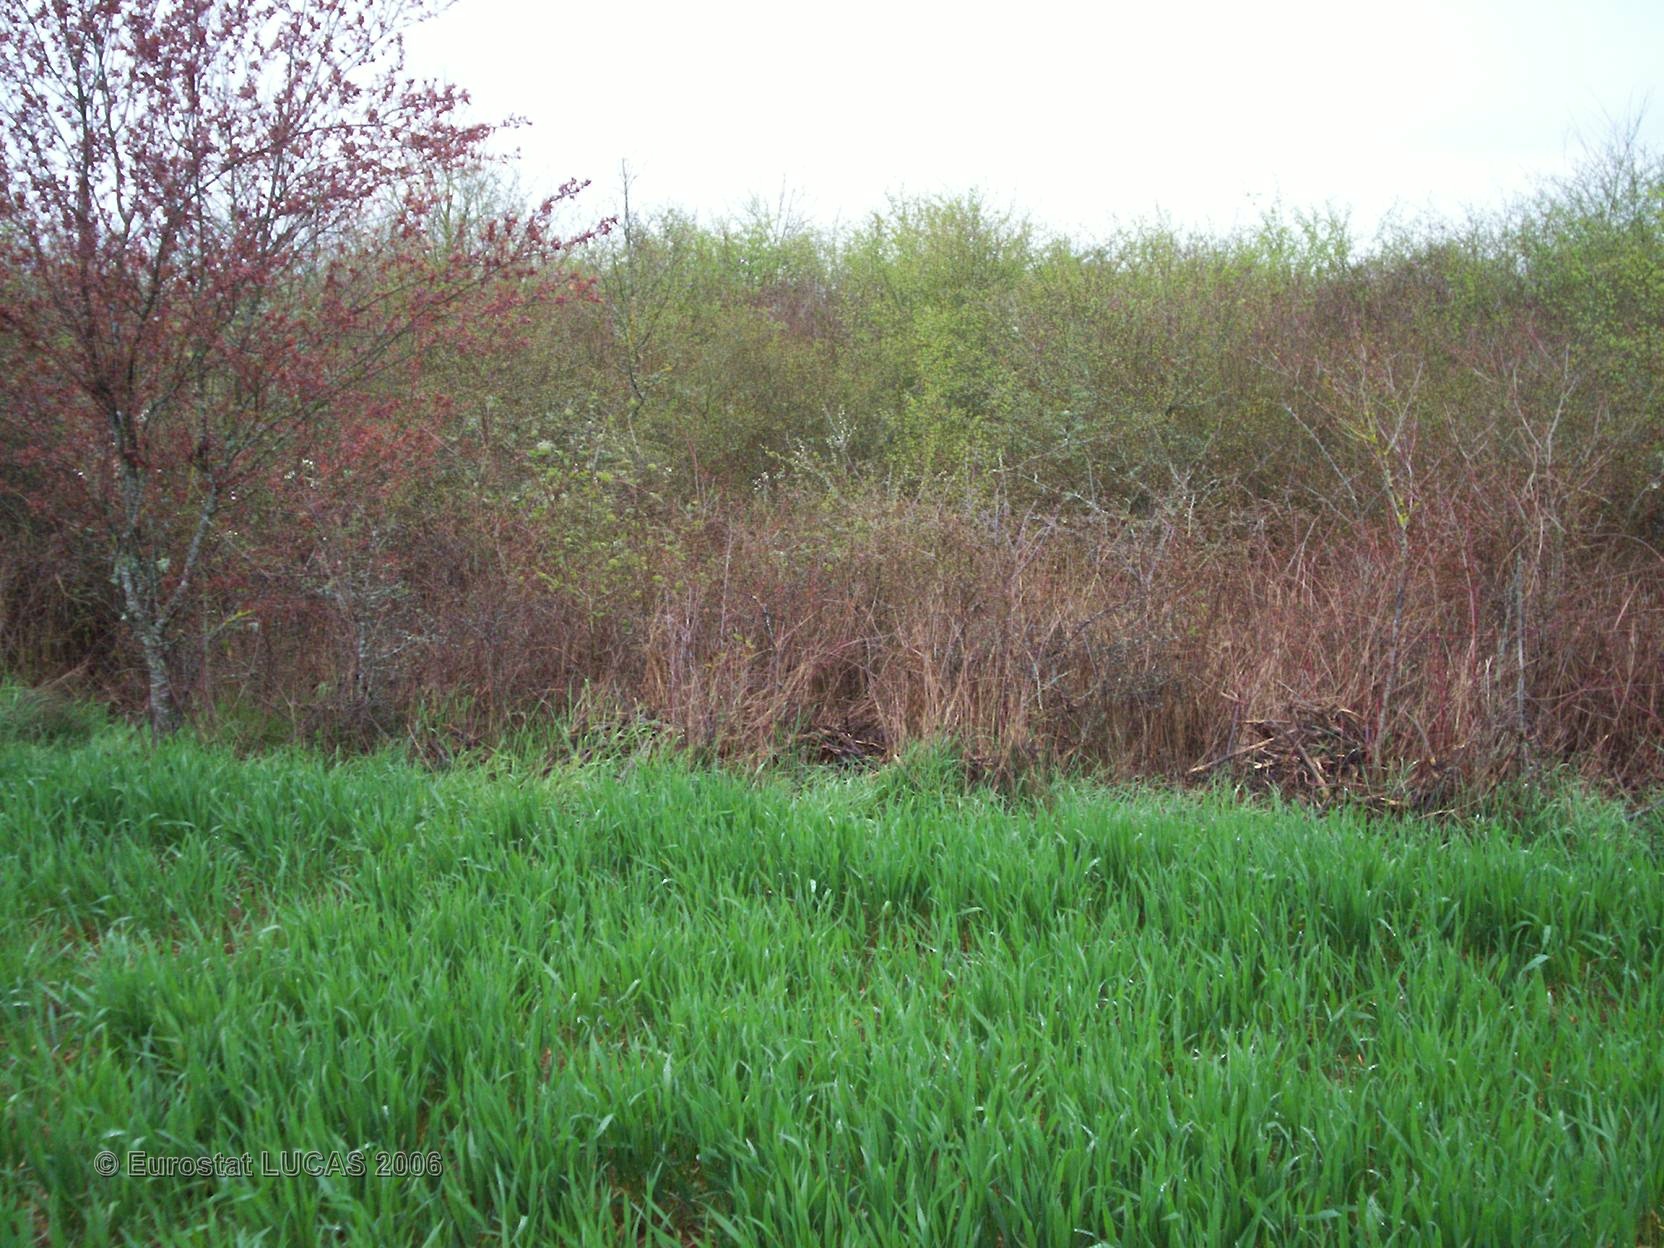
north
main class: Cropland
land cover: Common wheat
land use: Agriculture (excluding fallow land and kitchen gardens)
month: April
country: FR
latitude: 46.5574
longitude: 1.0777
